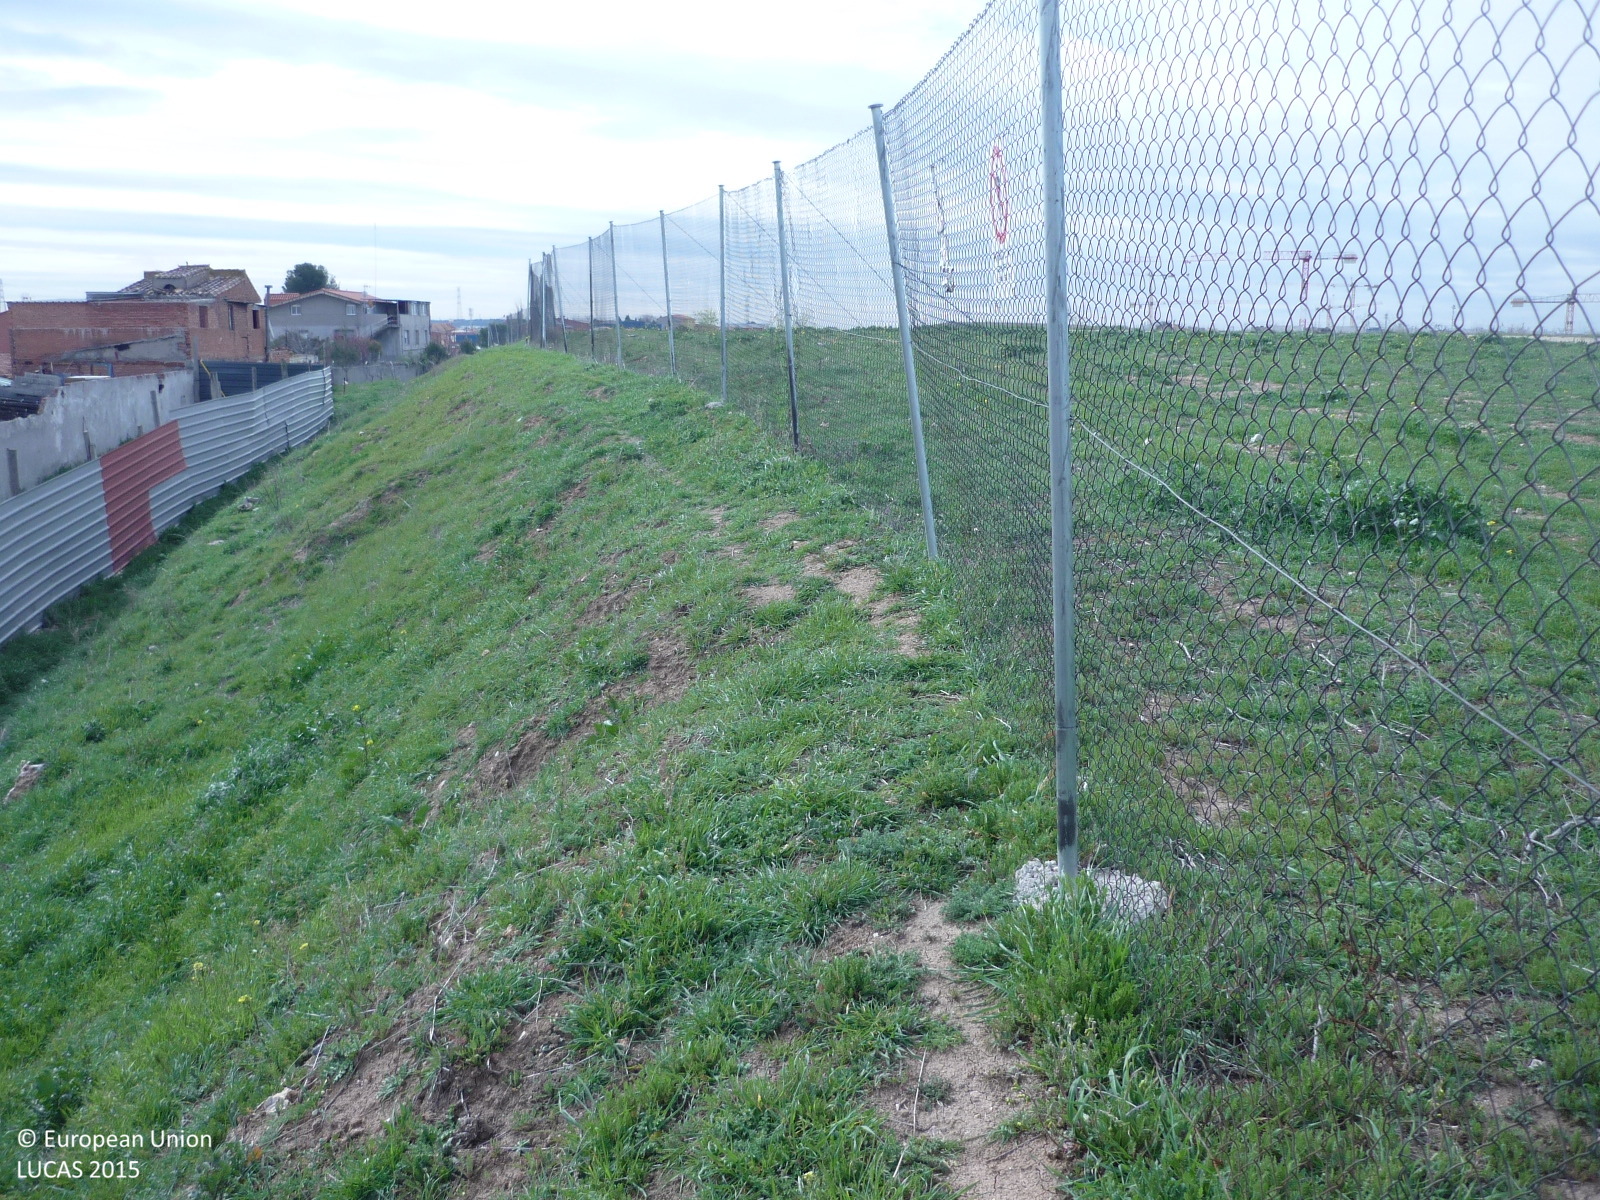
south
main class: Grassland
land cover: Spontaneously vegetated surfaces
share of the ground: > 75 %
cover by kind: herbaceous plants 90 %, unconsolidated bare surface 10 %
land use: Abandoned areas
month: March
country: ES
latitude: 40.4030
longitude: -3.5502
